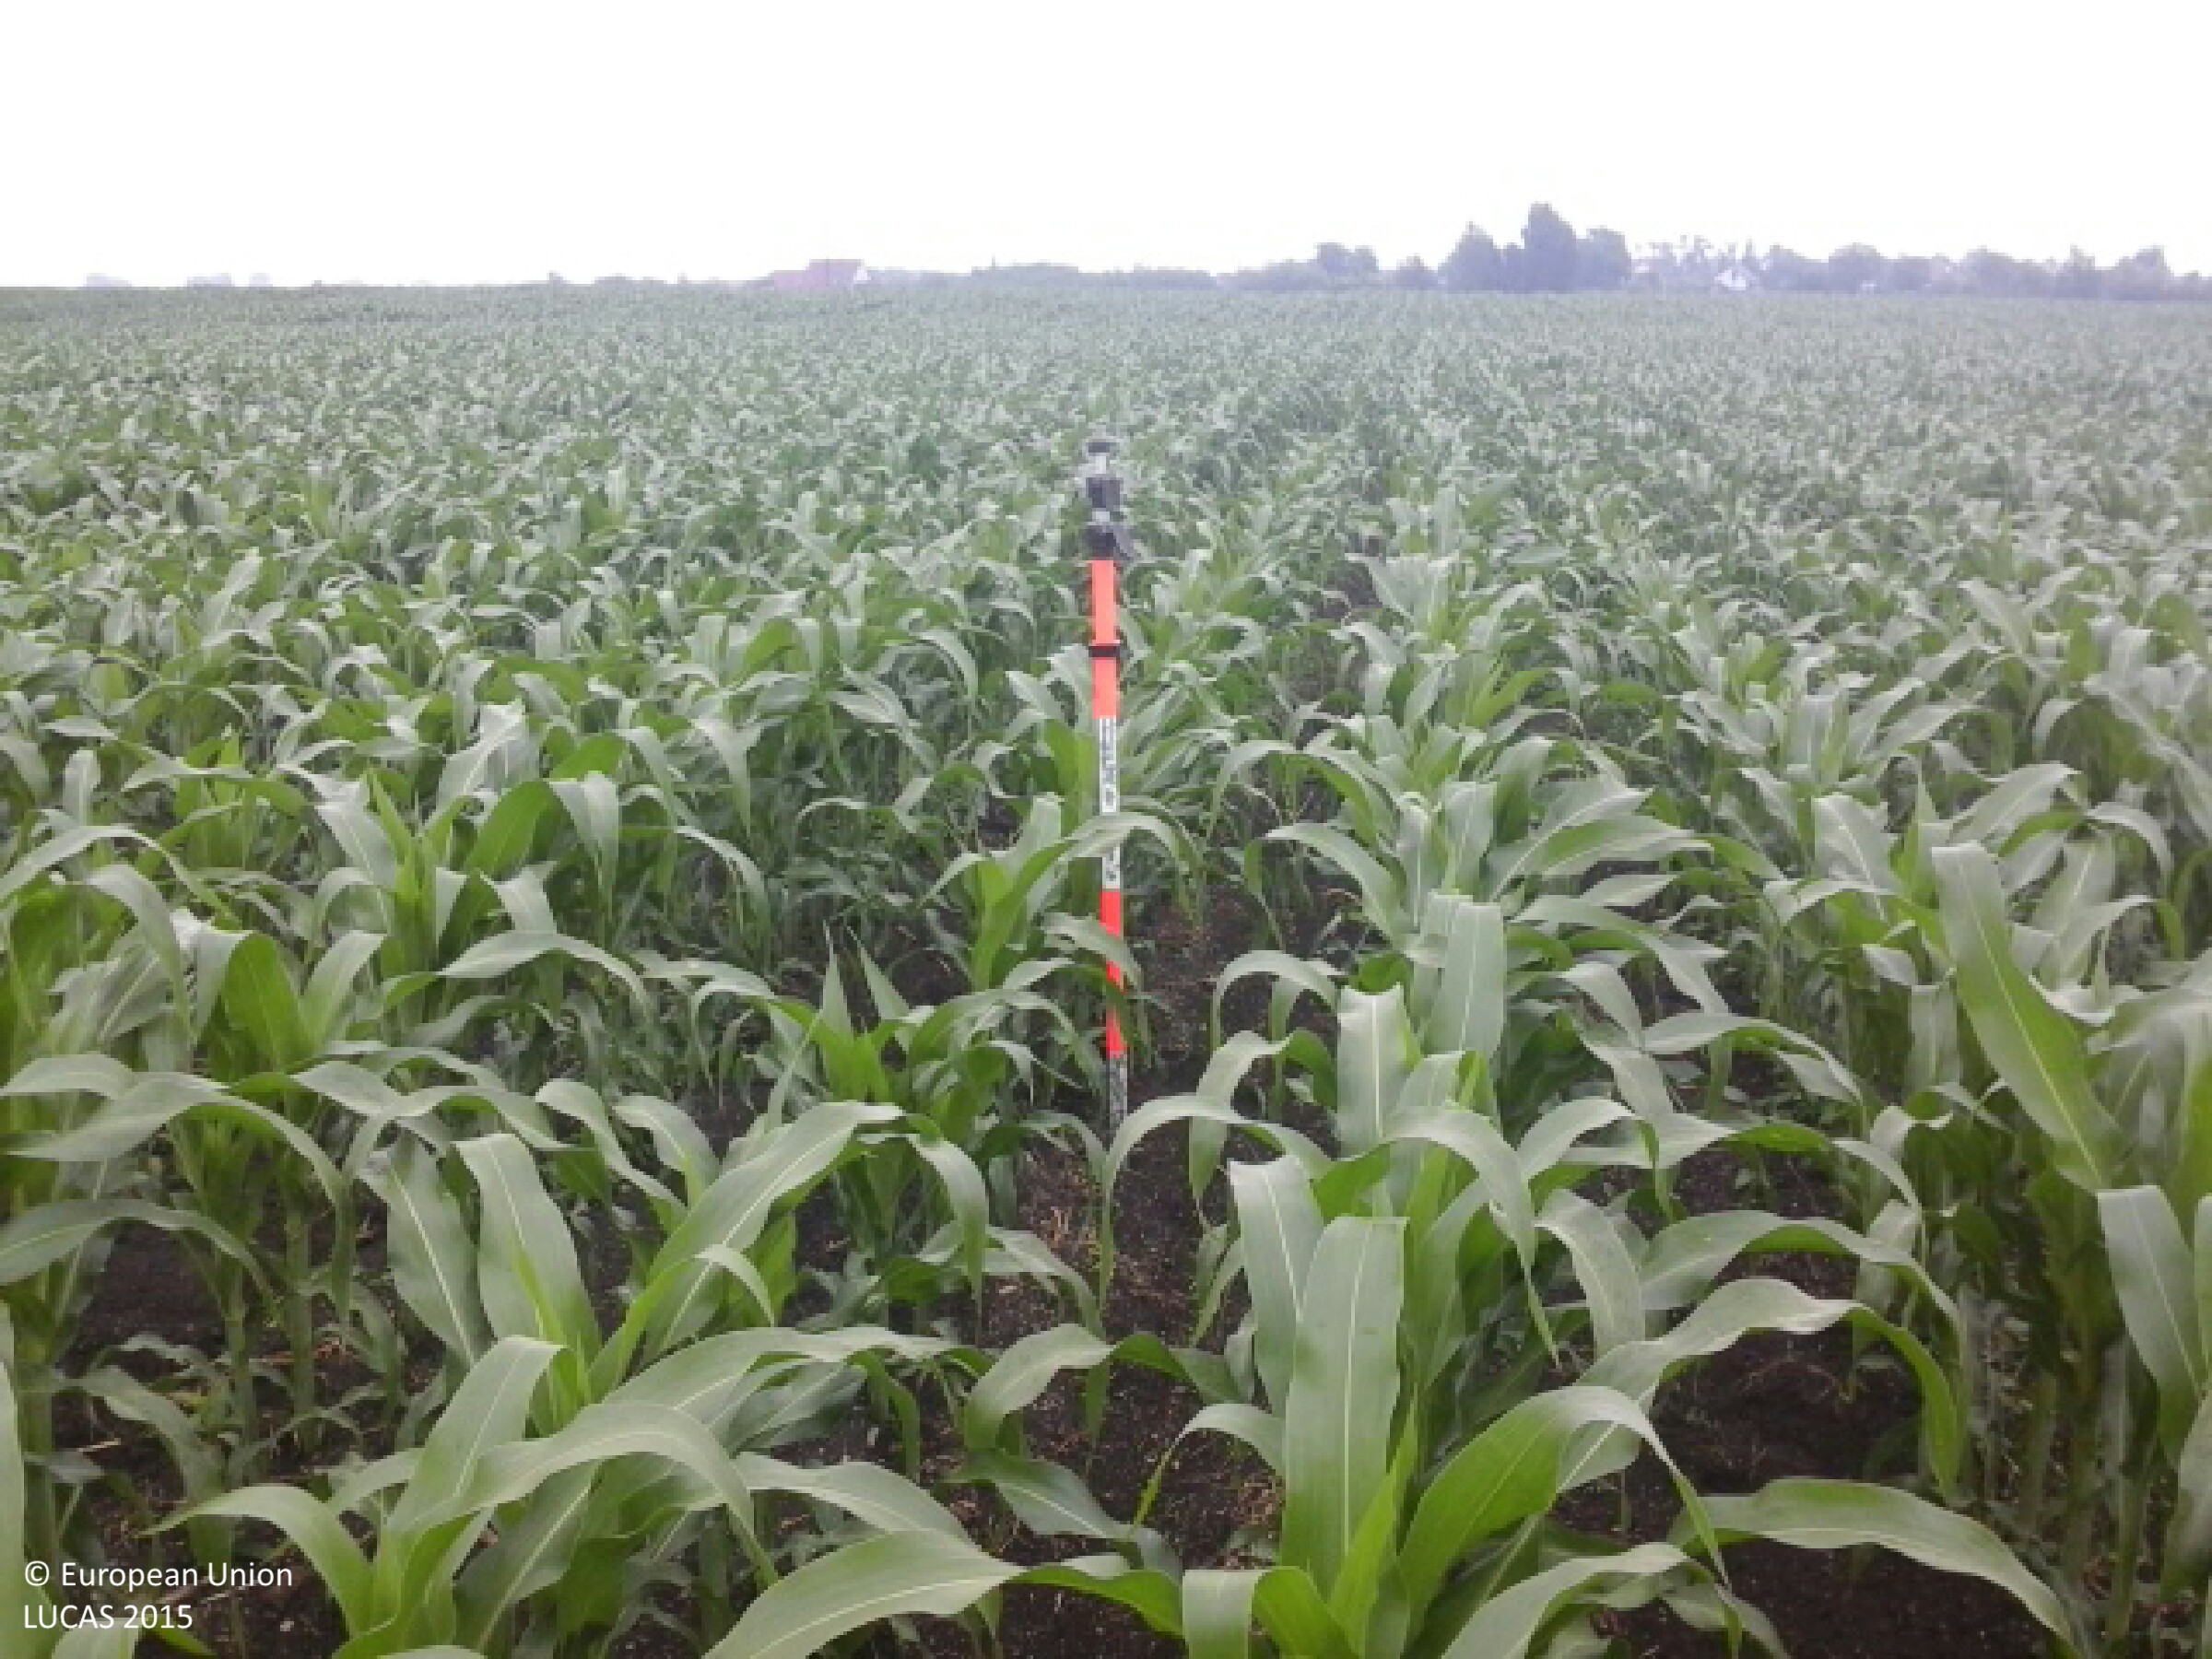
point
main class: Cropland
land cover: Maize
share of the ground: 50 - 75 %
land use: Agriculture (excluding fallow land and kitchen gardens)
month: June
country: HU
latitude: 48.1143
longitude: 21.8029
